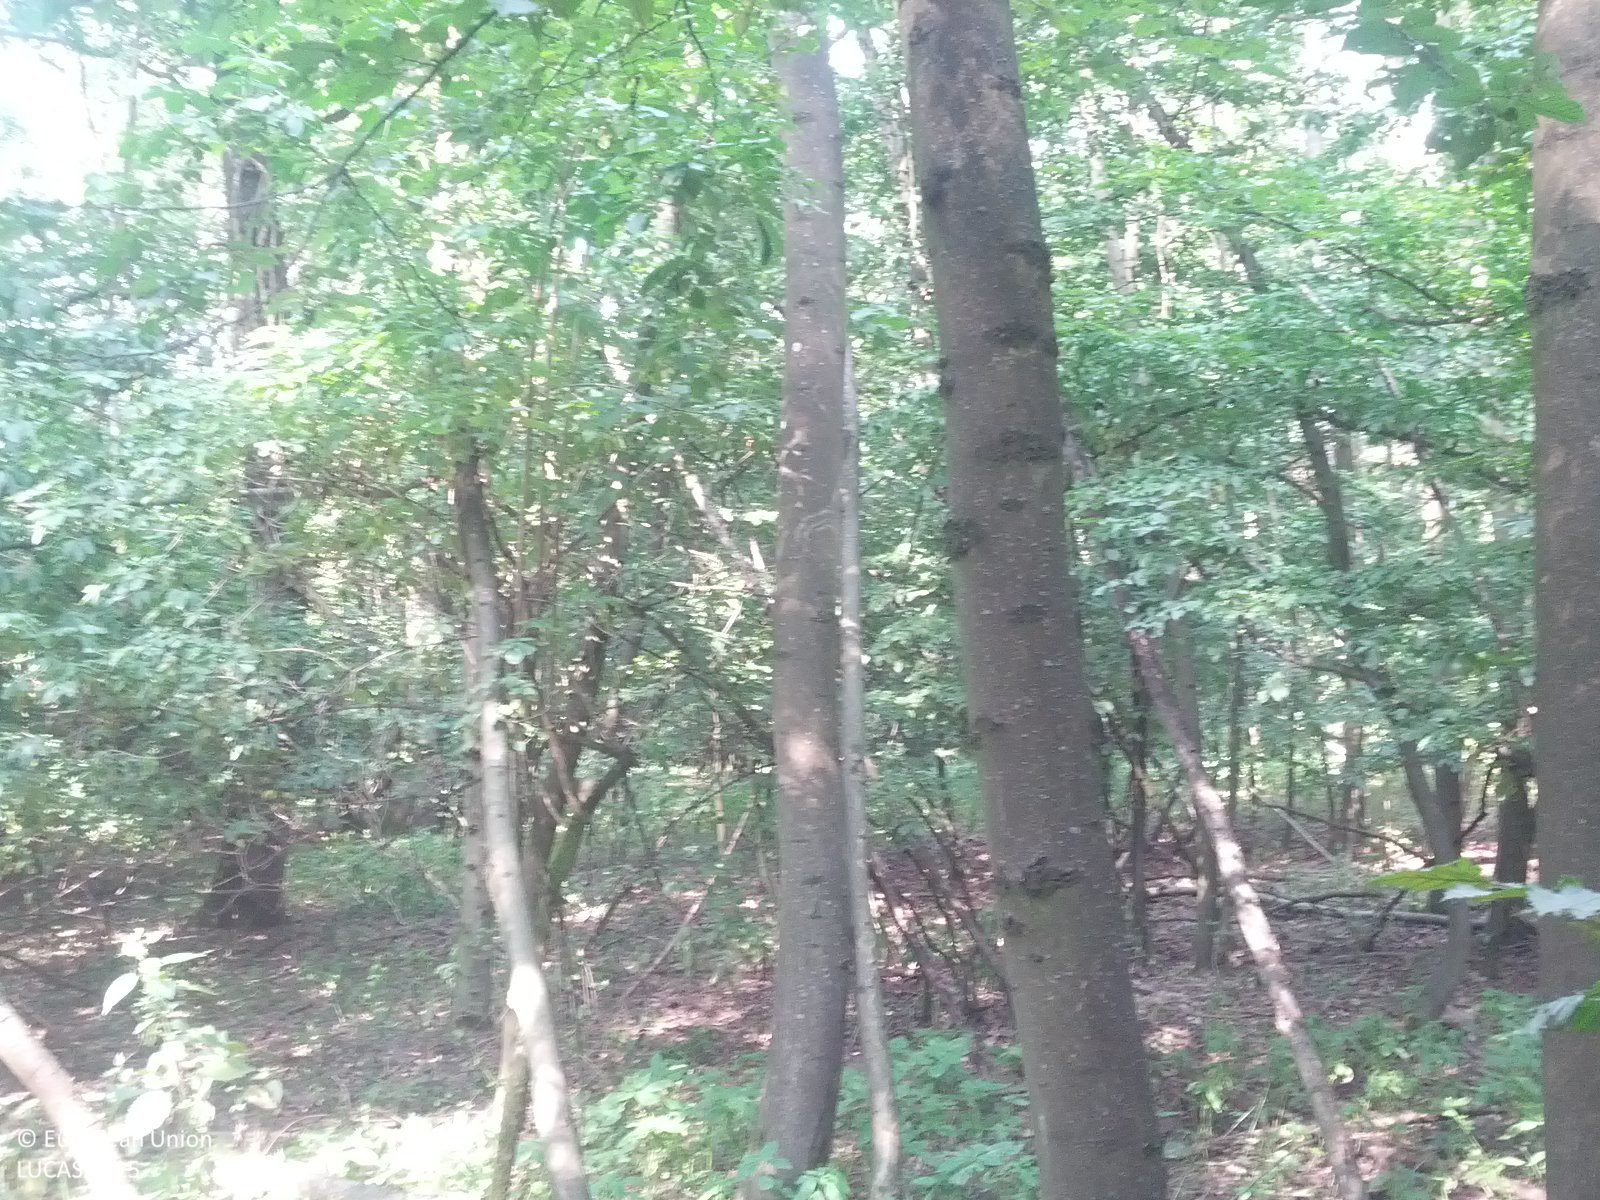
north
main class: Woodland
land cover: Broadleaved woodland
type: beech forest
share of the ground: > 75 %
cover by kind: broadleaved forest trees 95 %, herbaceous plants 5 %
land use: Forestry
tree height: > 5 m
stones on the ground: < 10 %
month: July
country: AT
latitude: 48.4035
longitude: 16.3134
